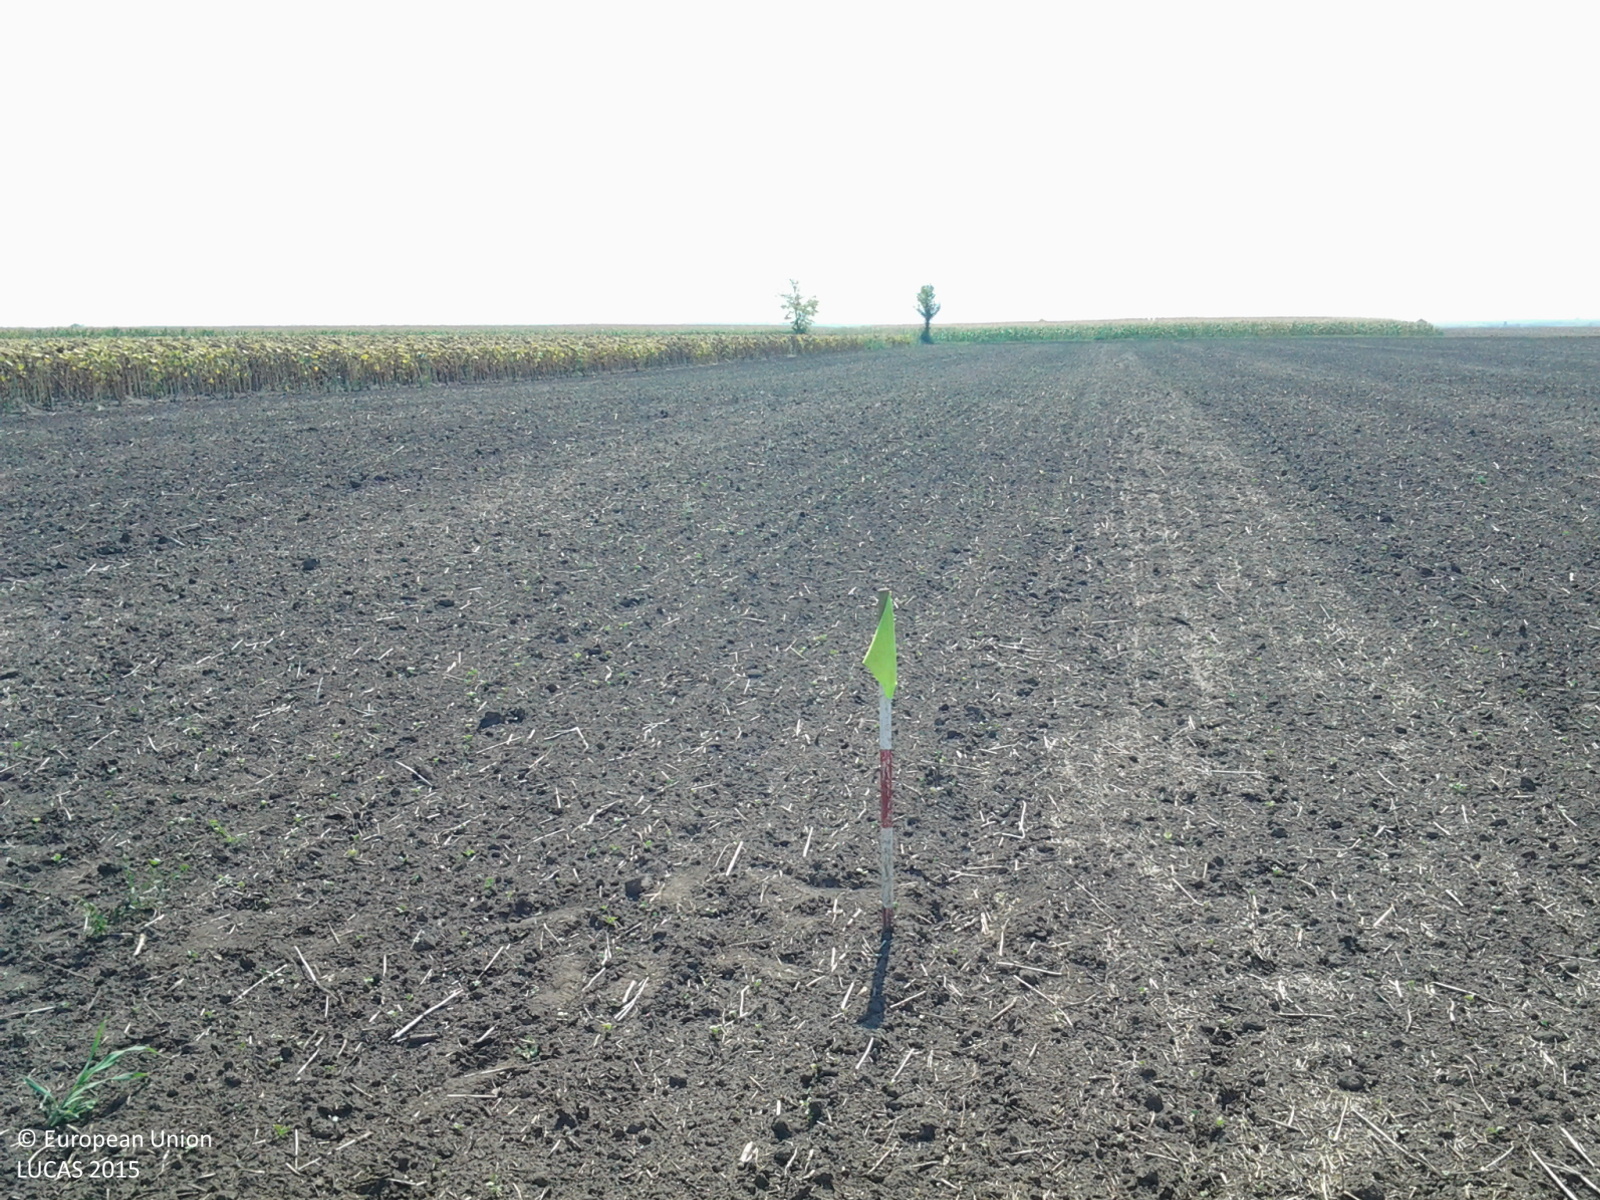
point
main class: Cropland
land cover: Rape and turnip rape
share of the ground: < 10 %
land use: Agriculture (excluding fallow land and kitchen gardens)
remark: Harvested field
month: August
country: HU
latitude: 47.3218
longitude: 19.7207
